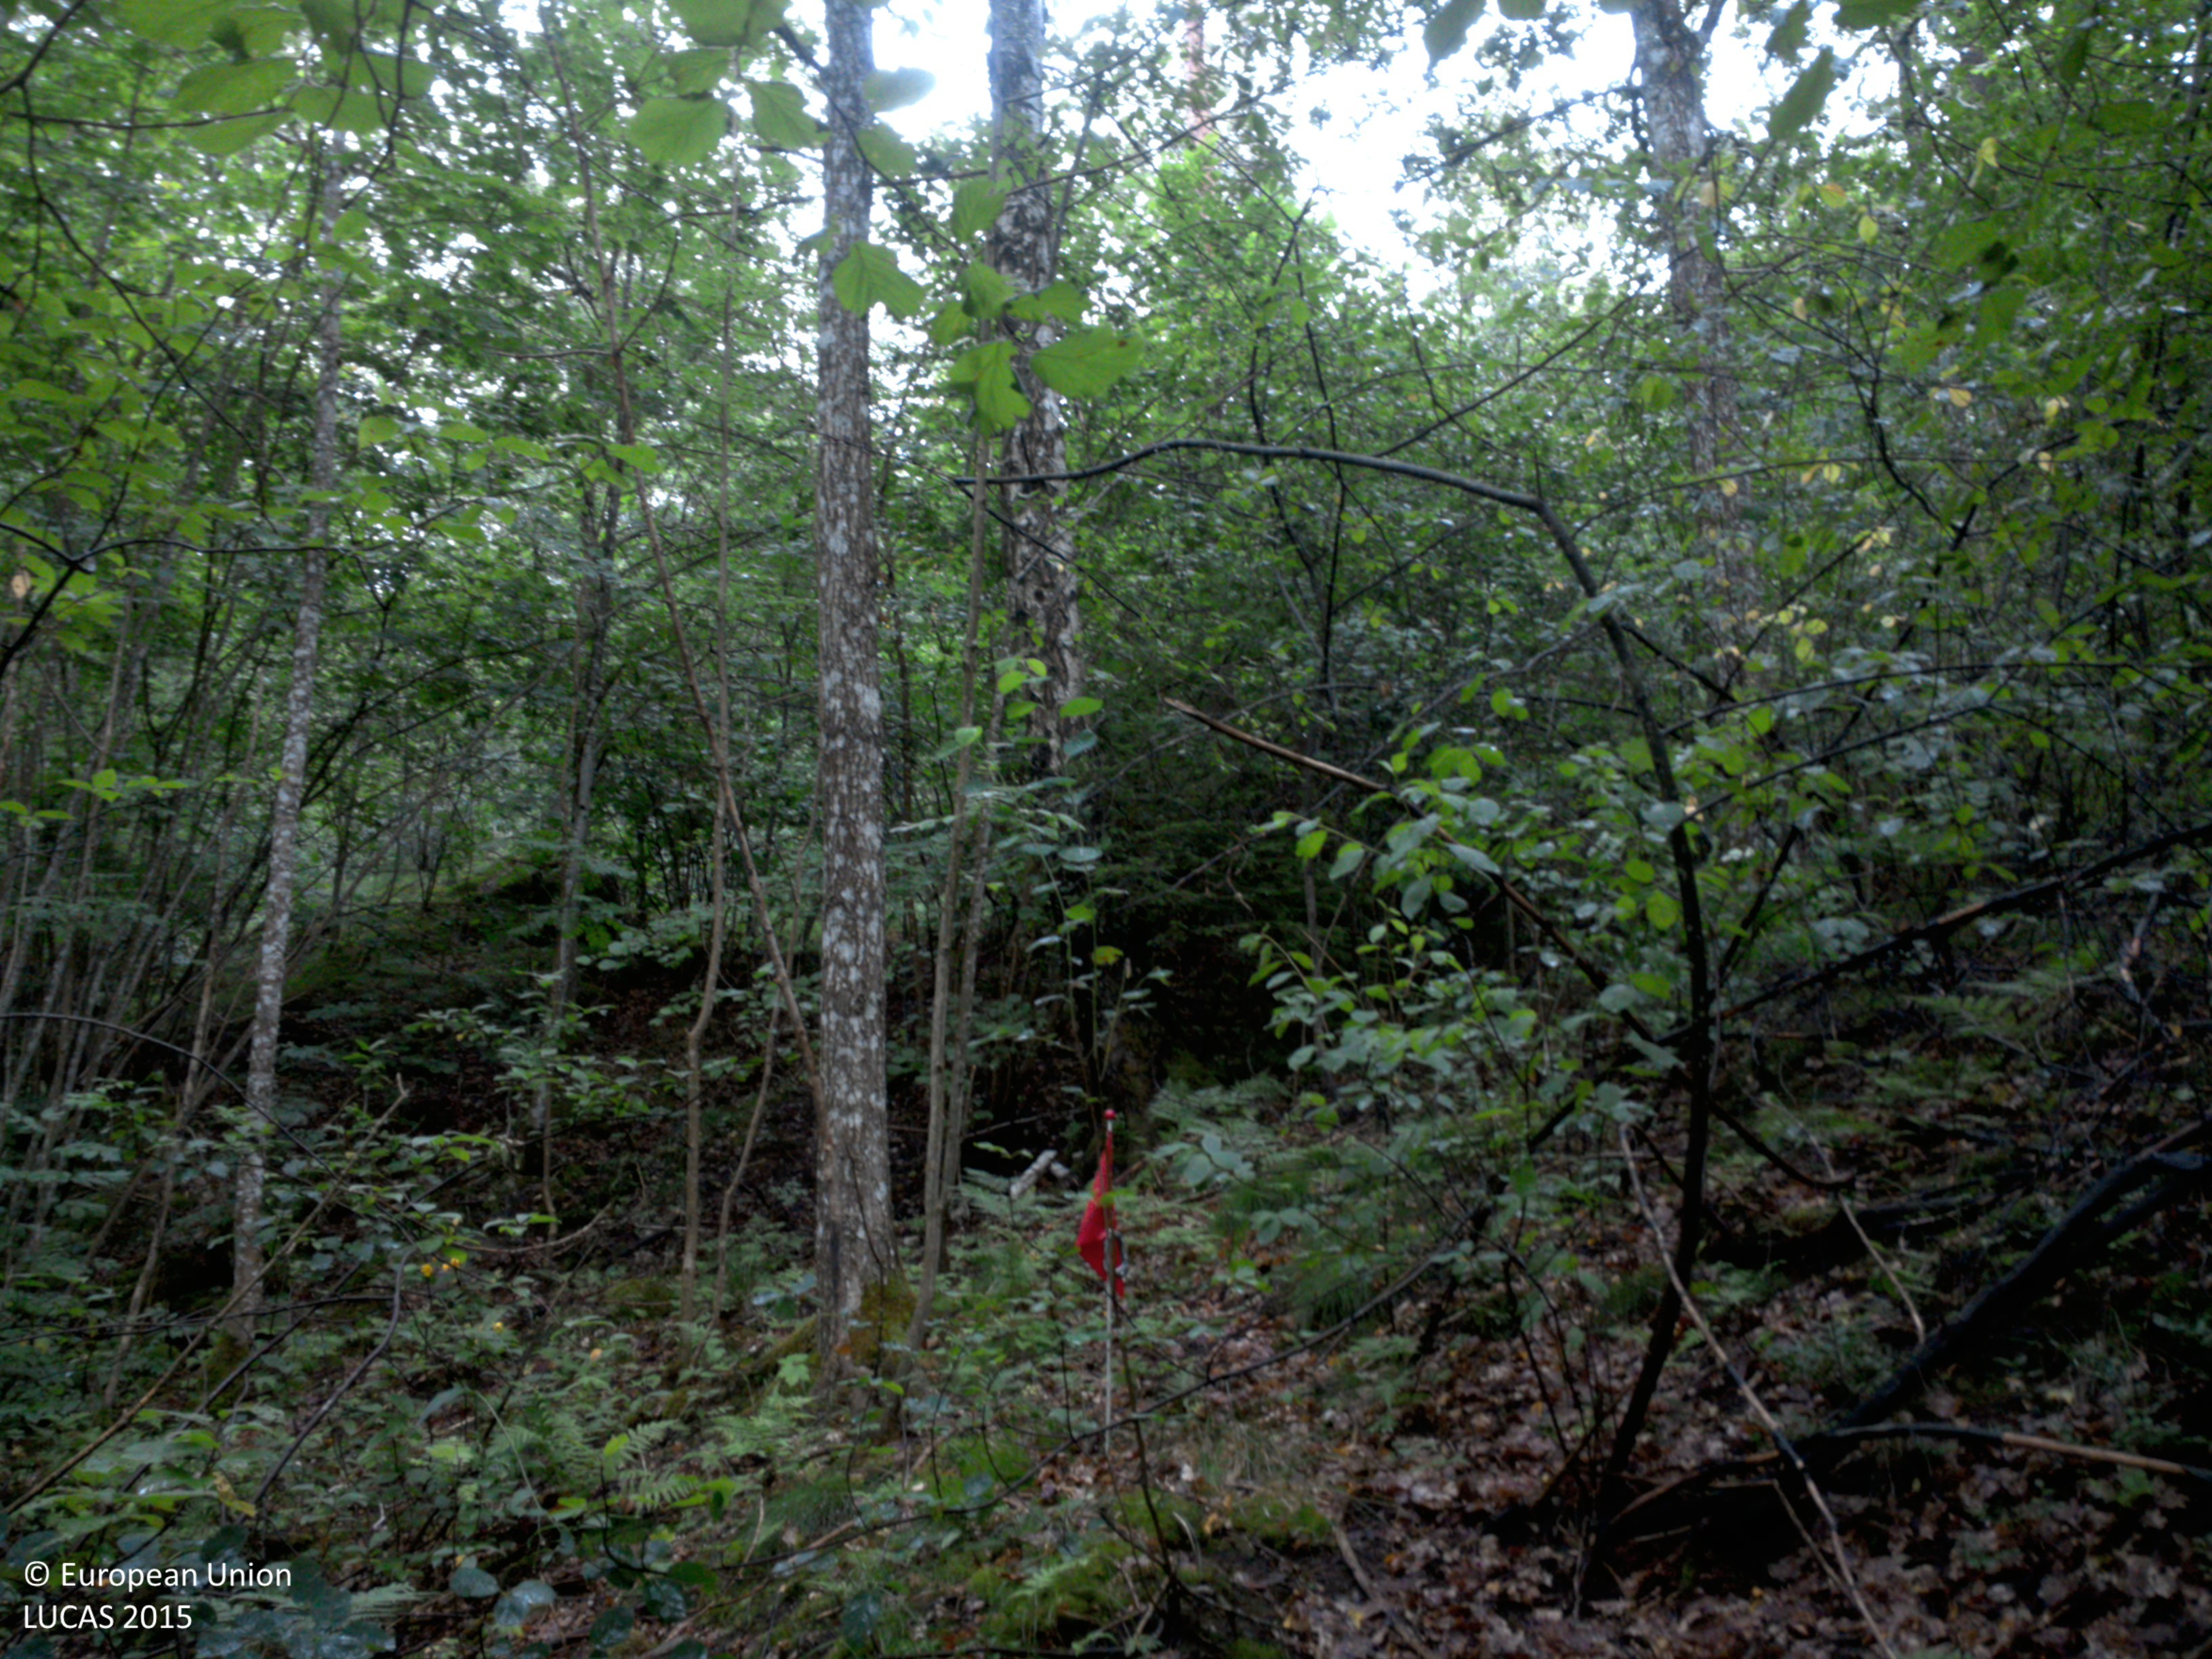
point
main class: Woodland
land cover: Broadleaved woodland
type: hemiboreal forest and nemoral coniferous forest and mixed broadleaved-coniferous forest
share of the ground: 50 - 75 %
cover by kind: broadleaved forest trees 75 %, herbaceous plants 25 %
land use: Semi-natural and natural areas not in use
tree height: > 5 m
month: July
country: SE
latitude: 58.6742
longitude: 11.8756
